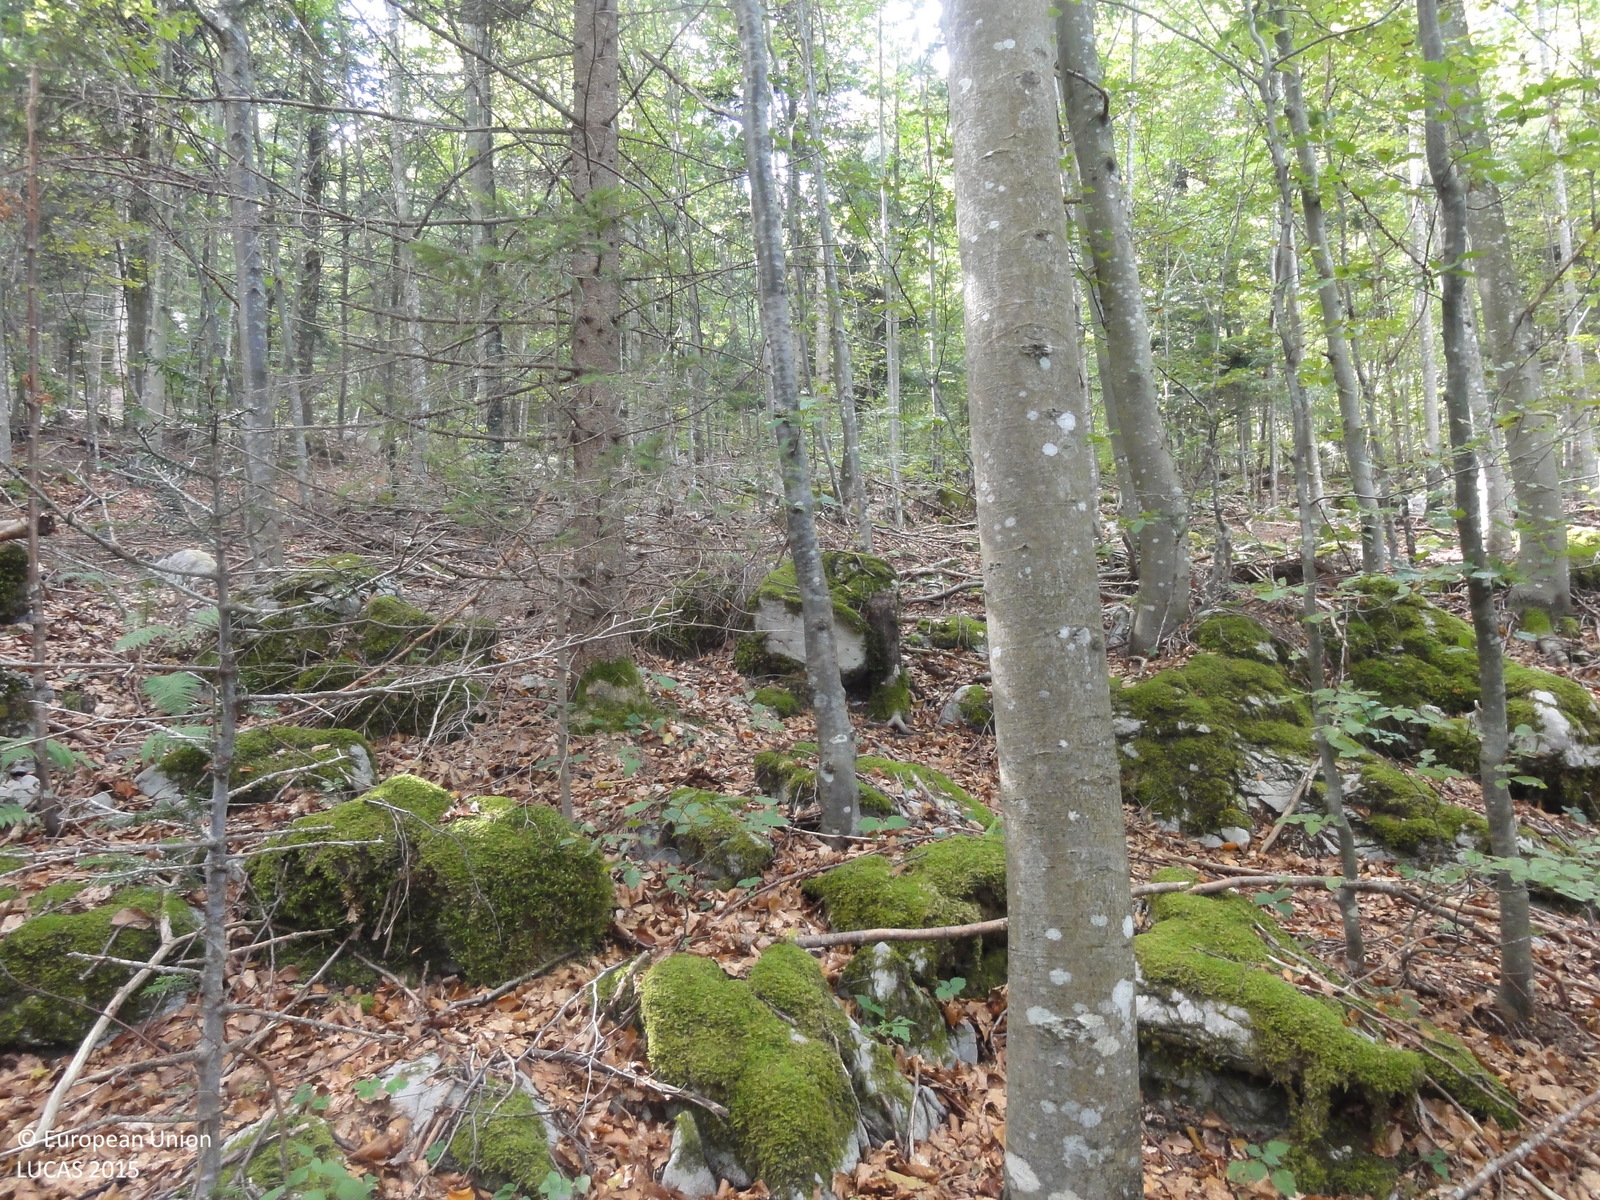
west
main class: Woodland
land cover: Spruce dominated mixed woodland
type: mountainous beech forest
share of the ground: > 75 %
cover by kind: broadleaved forest trees 60 %, coniferous forest trees 40 %
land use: Forestry
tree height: > 5 m
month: September
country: SI
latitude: 45.6729
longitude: 15.0410
